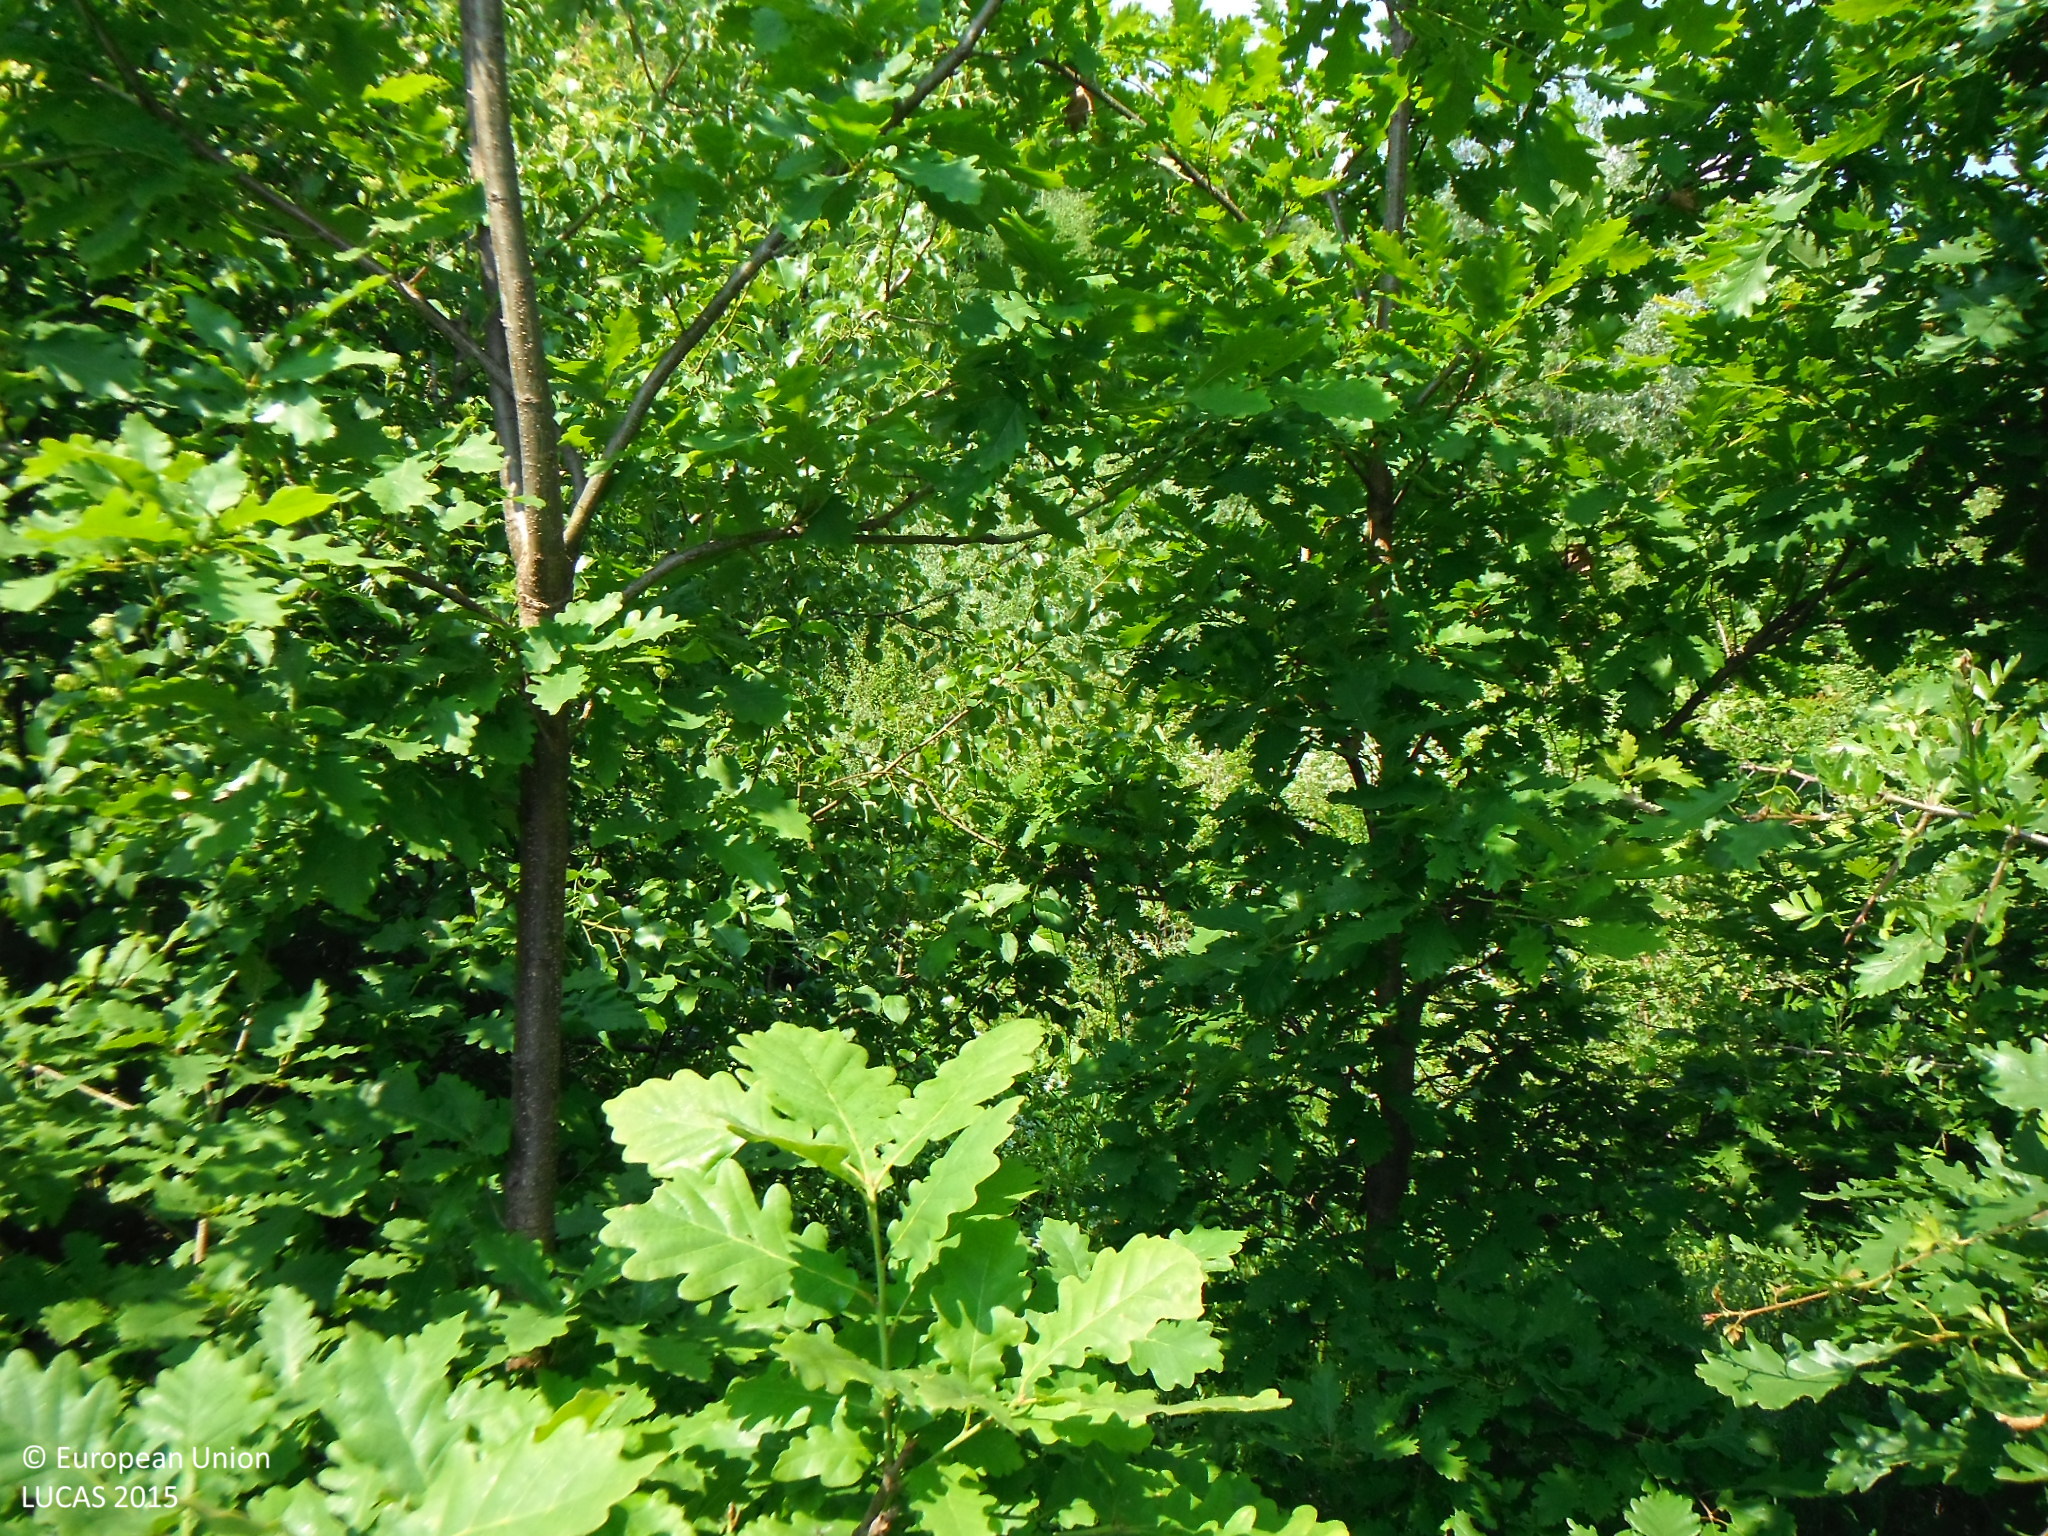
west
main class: Woodland
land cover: Broadleaved woodland
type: mesophytic deciduous forest
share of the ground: > 75 %
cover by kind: broadleaved forest trees 95 %, coniferous forest trees 5 %
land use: Forestry
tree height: > 5 m
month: June
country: SK
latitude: 48.8485
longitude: 21.5642
